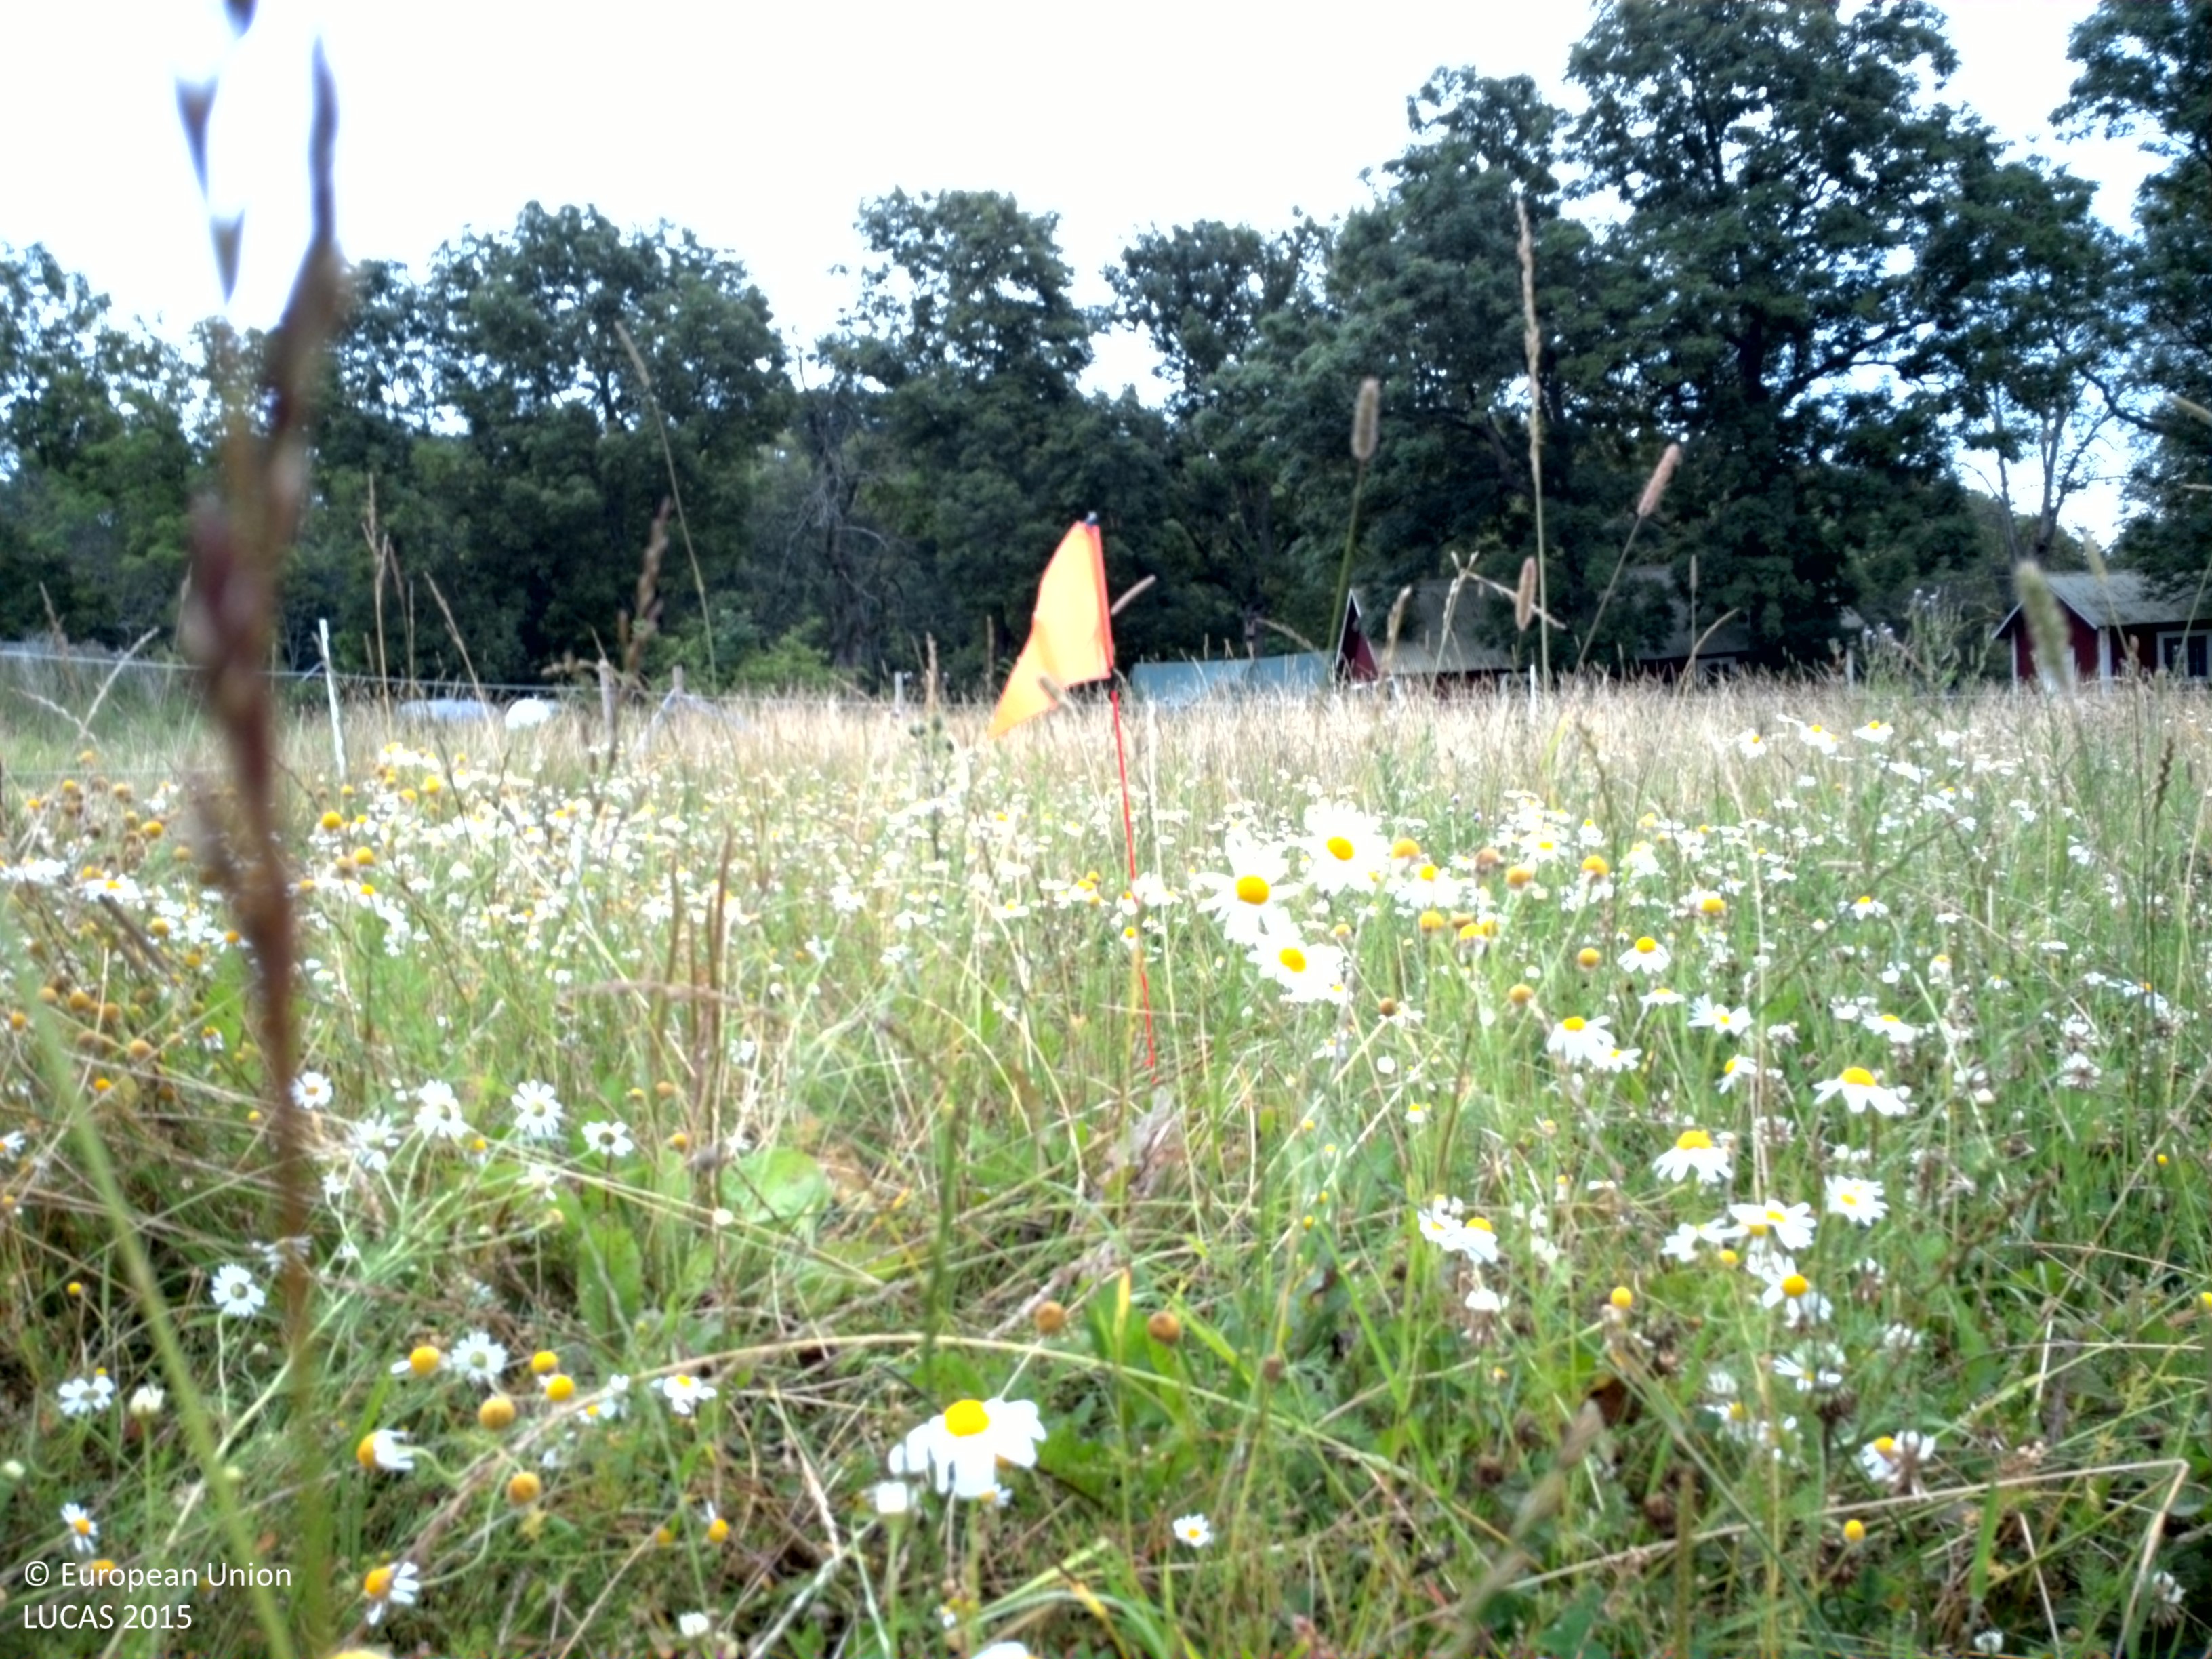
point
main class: Grassland
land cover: Grassland without tree/shrub cover
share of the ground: > 75 %
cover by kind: herbaceous plants 100 %
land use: Agriculture (excluding fallow land and kitchen gardens)
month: July
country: SE
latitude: 59.4665
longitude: 18.2754
